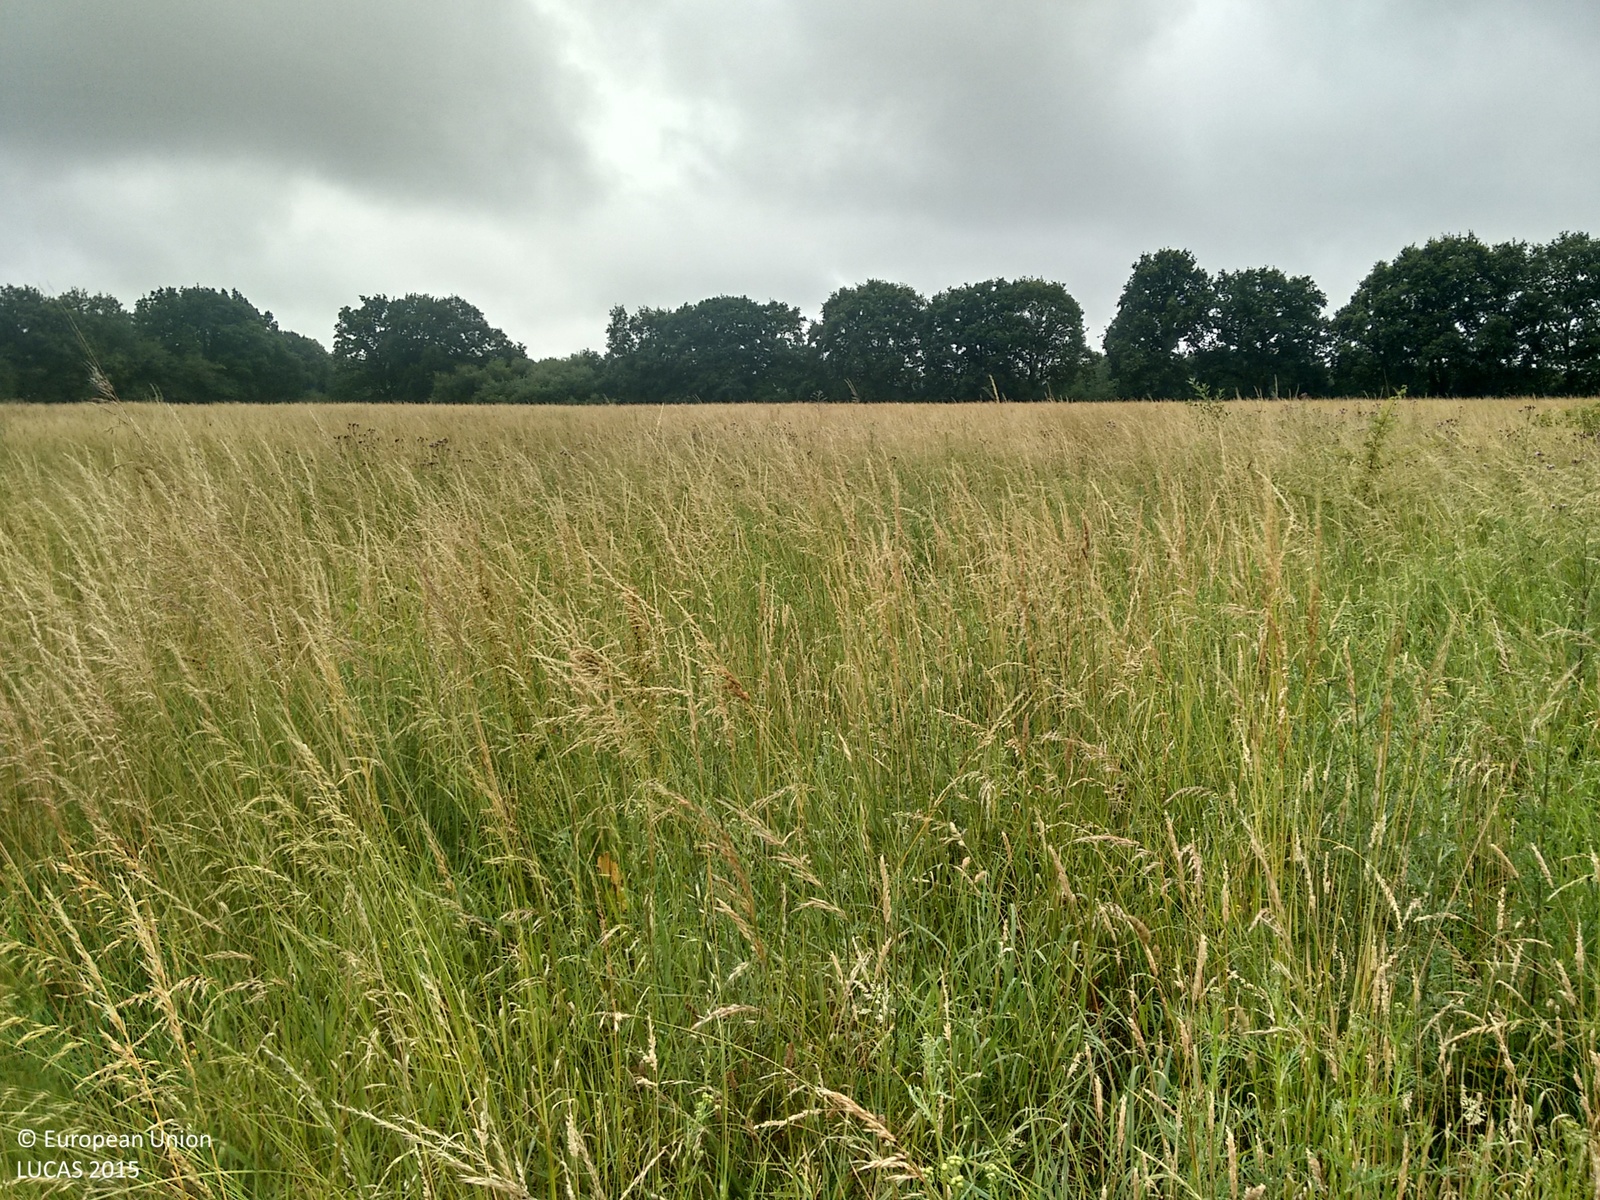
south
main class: Grassland
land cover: Grassland without tree/shrub cover
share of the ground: > 75 %
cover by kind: herbaceous plants 100 %
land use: Agriculture (excluding fallow land and kitchen gardens)
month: July
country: GB
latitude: 51.6474
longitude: 0.4476
